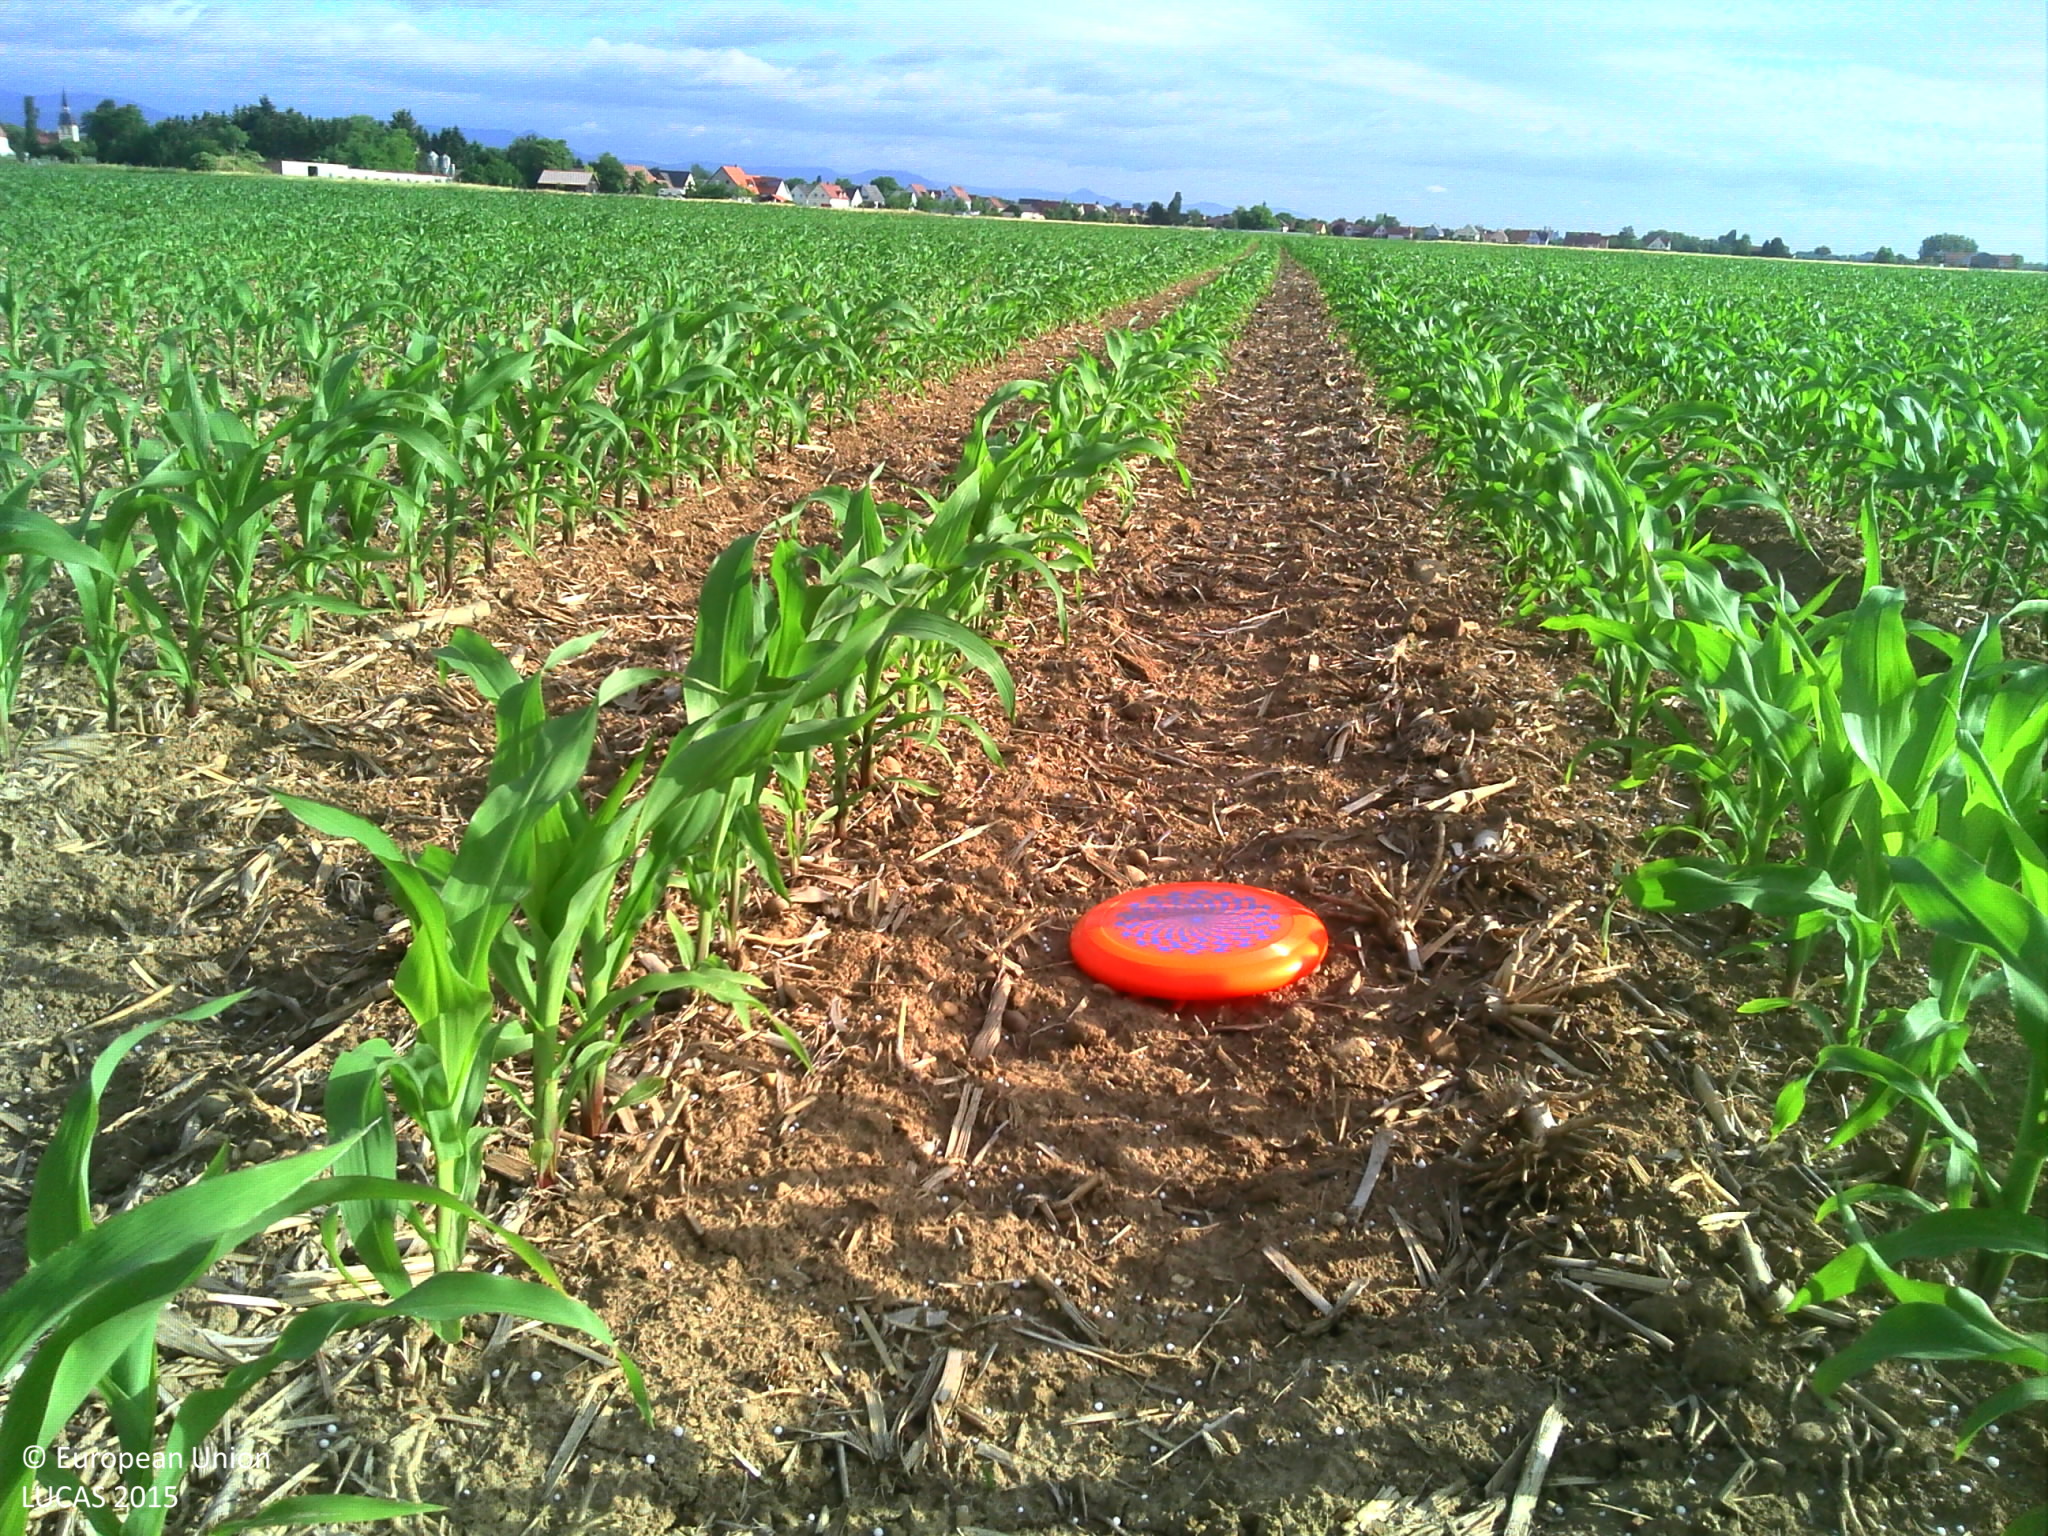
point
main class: Cropland
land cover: Maize
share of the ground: 10 - 25 %
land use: Agriculture (excluding fallow land and kitchen gardens)
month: June
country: FR
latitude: 48.0132
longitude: 7.4139
